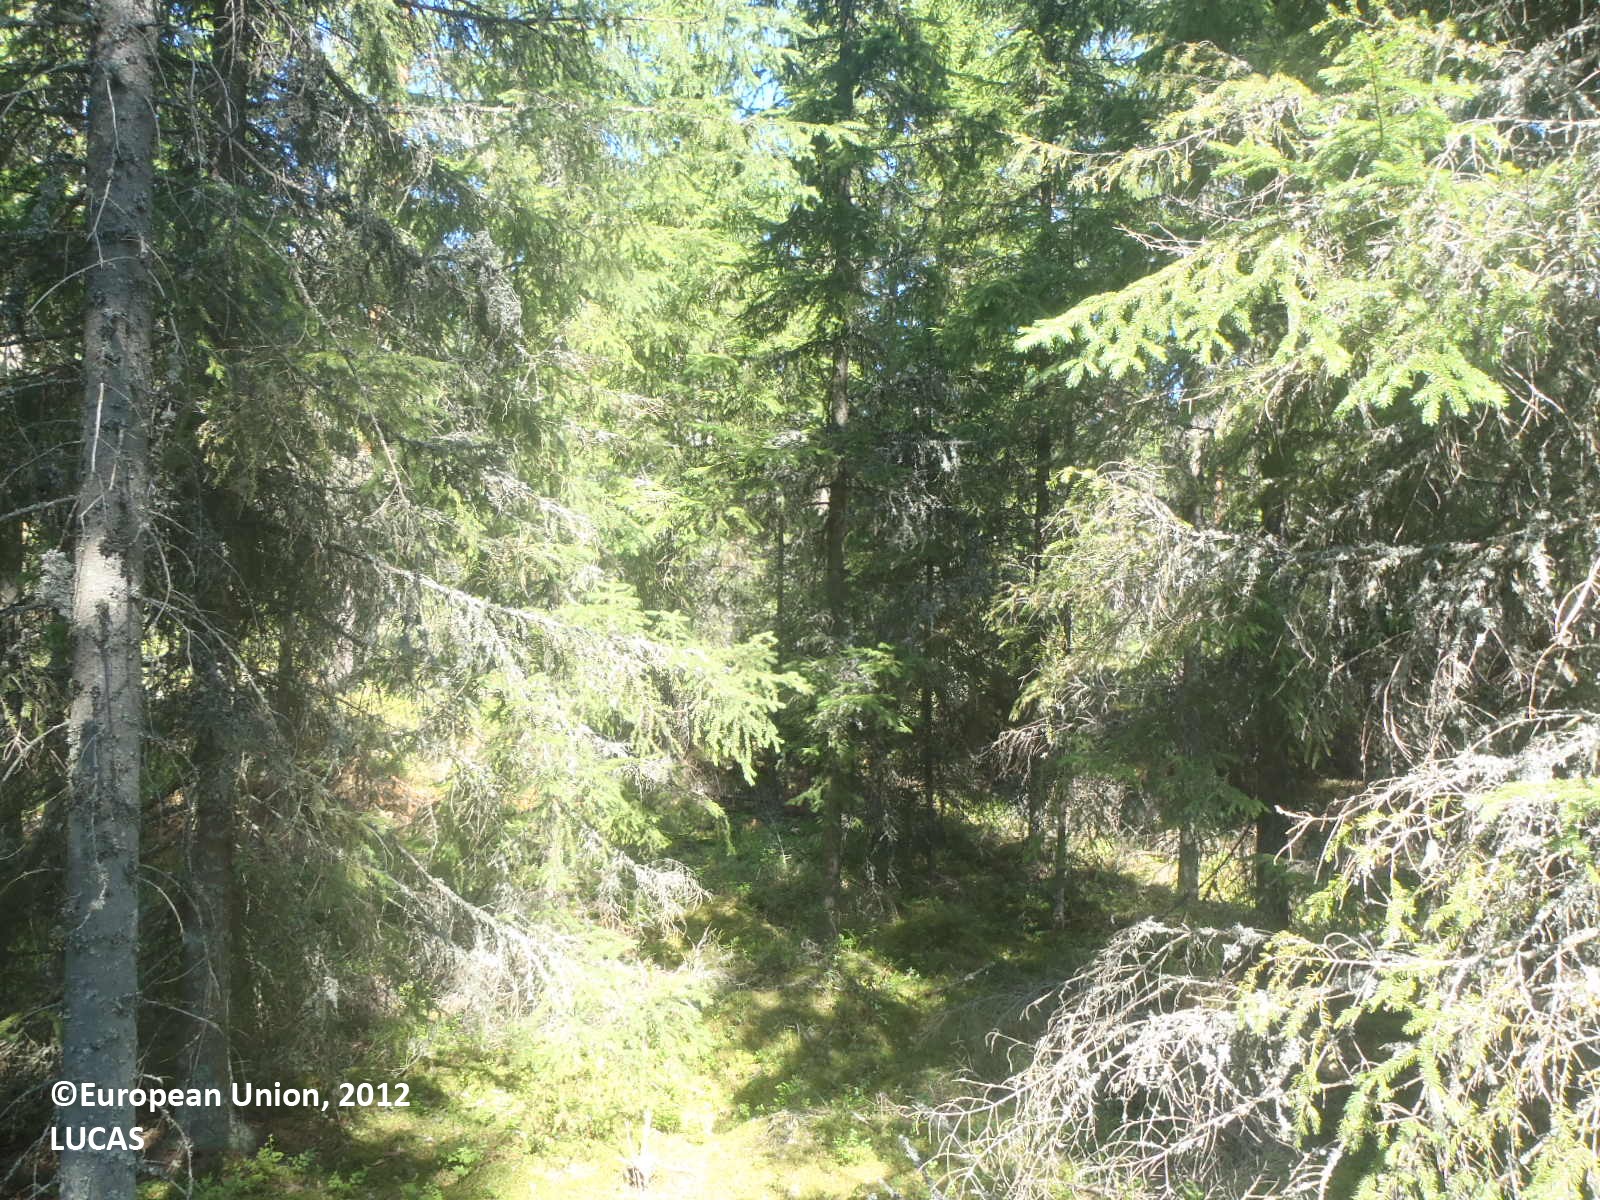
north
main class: Woodland
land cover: Spruce dominated coniferous woodland
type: boreal forest
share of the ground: 50 - 75 %
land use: Forestry
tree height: > 5 m
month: July
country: FI
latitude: 61.0291
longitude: 21.8472
